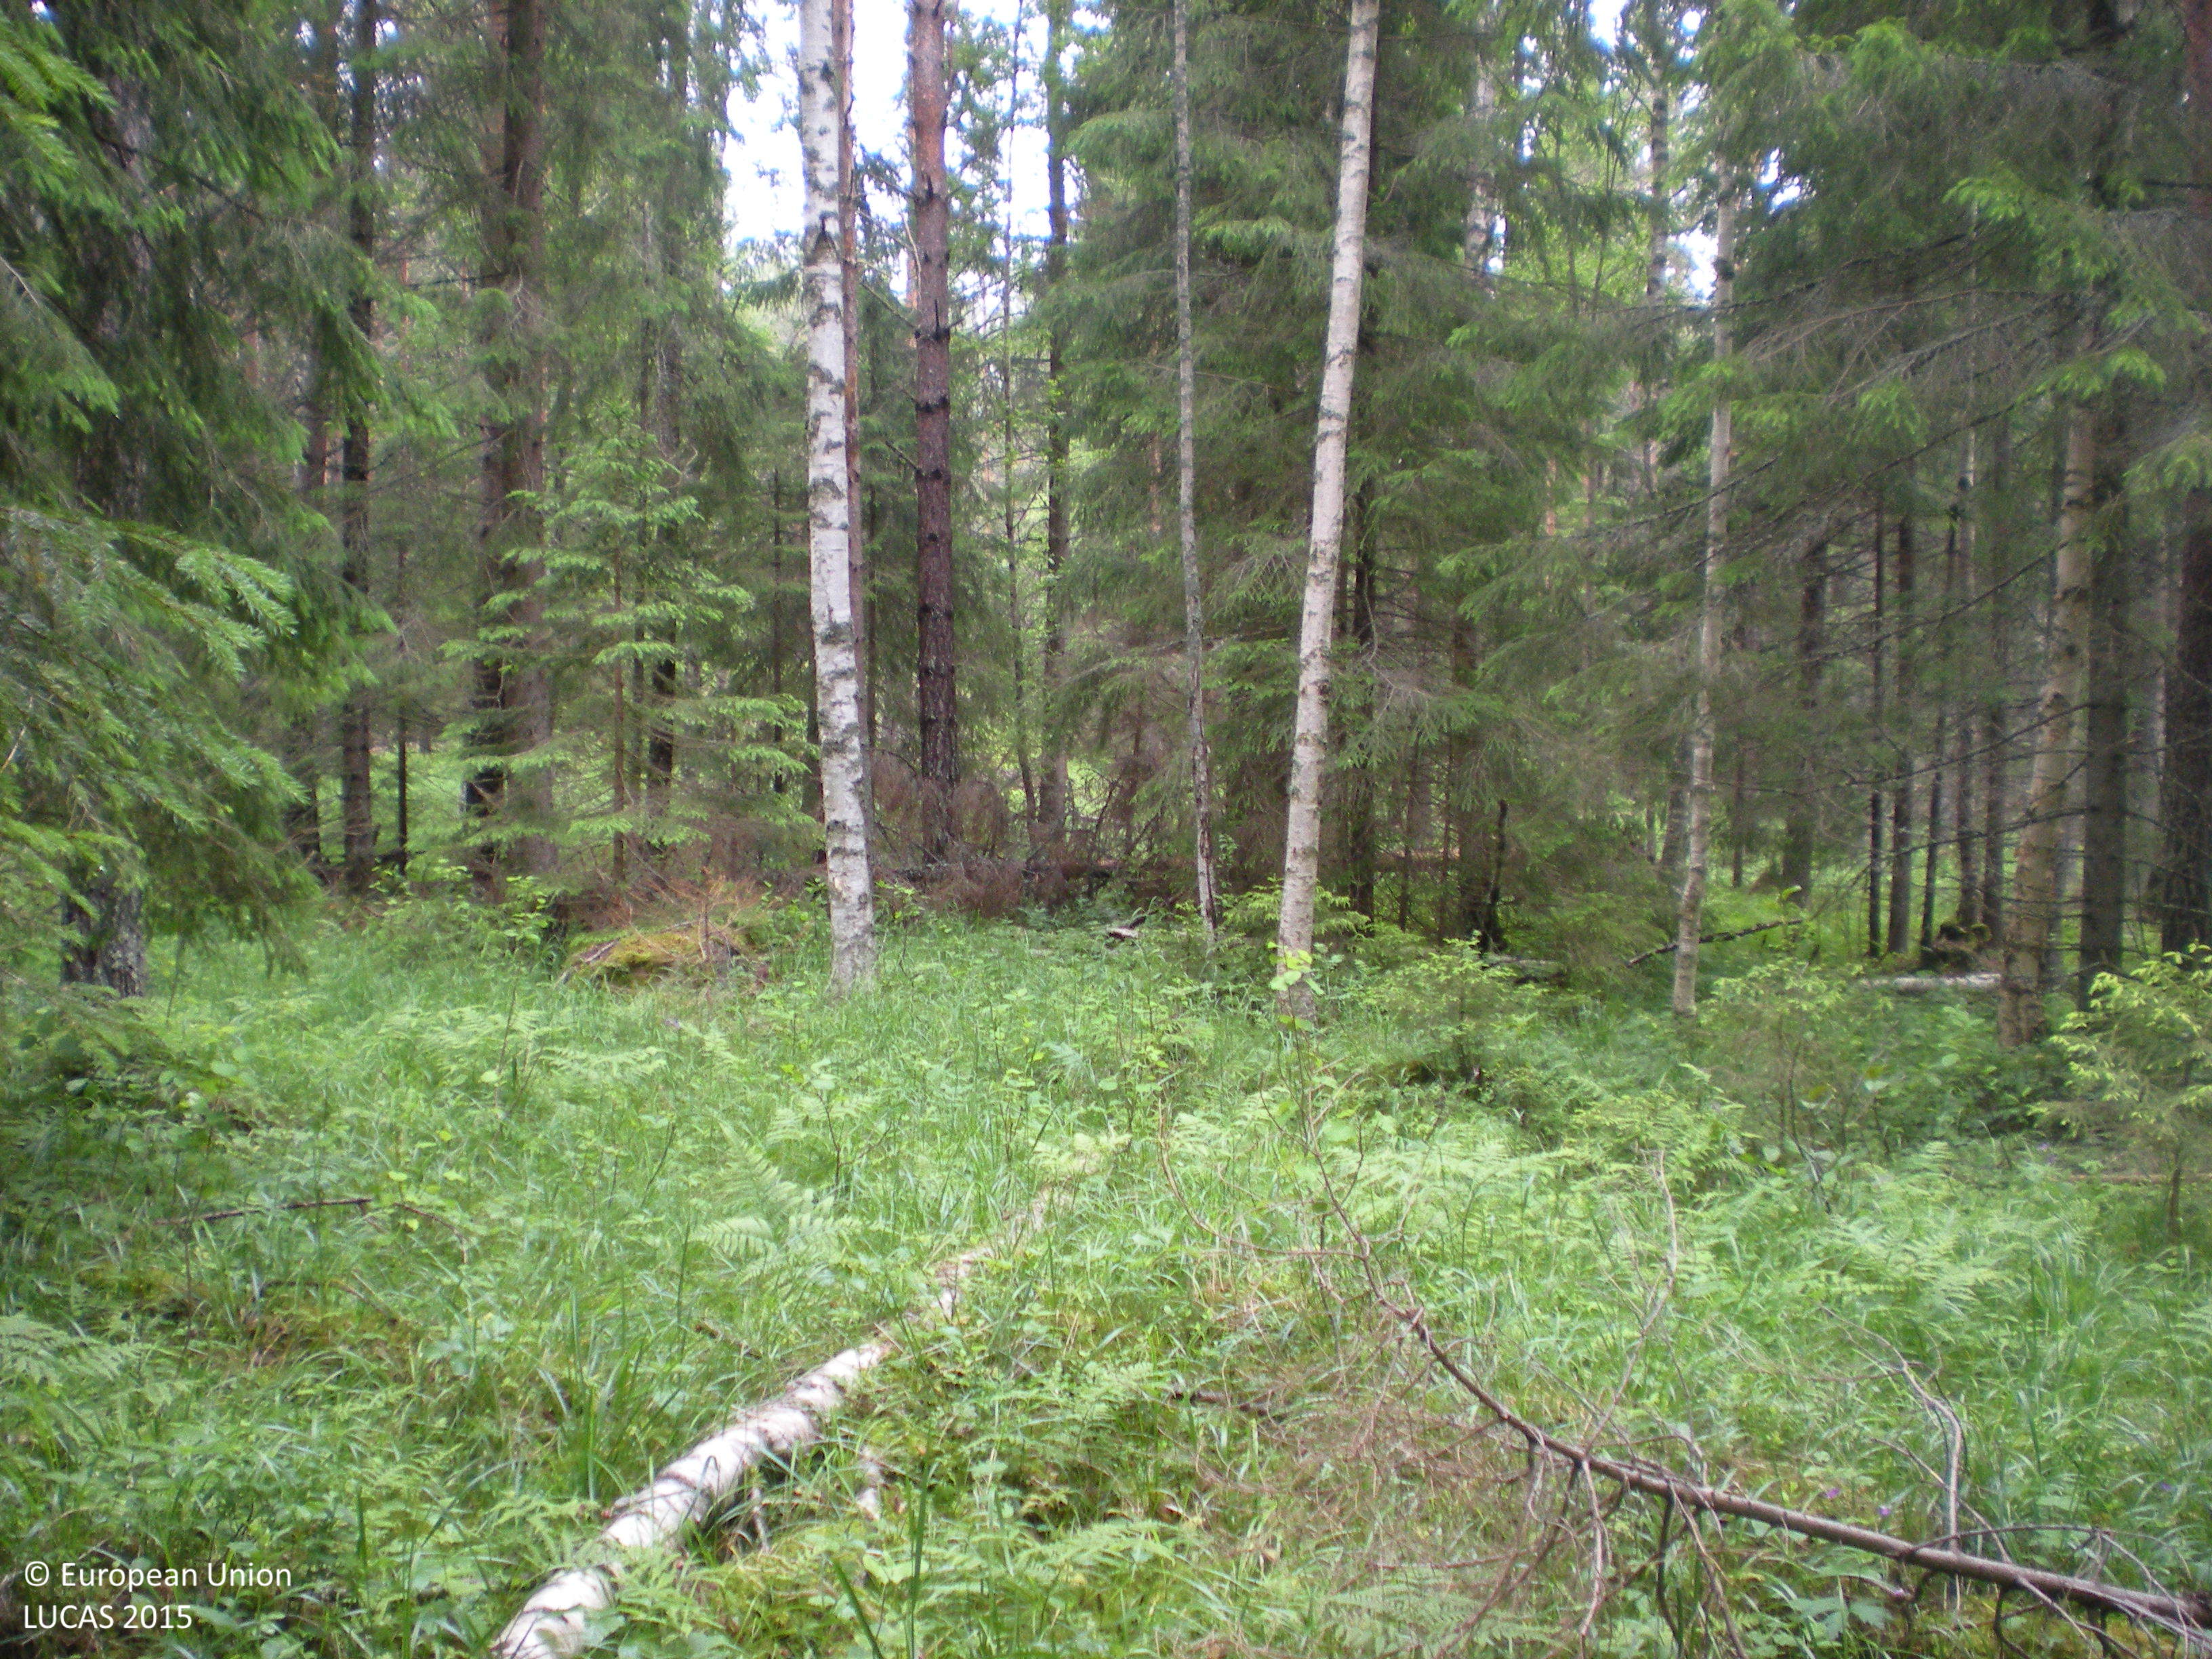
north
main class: Woodland
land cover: Other coniferous woodland
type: boreal forest
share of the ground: > 75 %
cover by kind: coniferous forest trees 55 %, broadleaved forest trees 15 %, herbaceous plants 15 %, shrubs 5 %, lichens and mosses 5 %
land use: Forestry
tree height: > 5 m
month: June
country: SE
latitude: 60.3983
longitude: 17.8146
